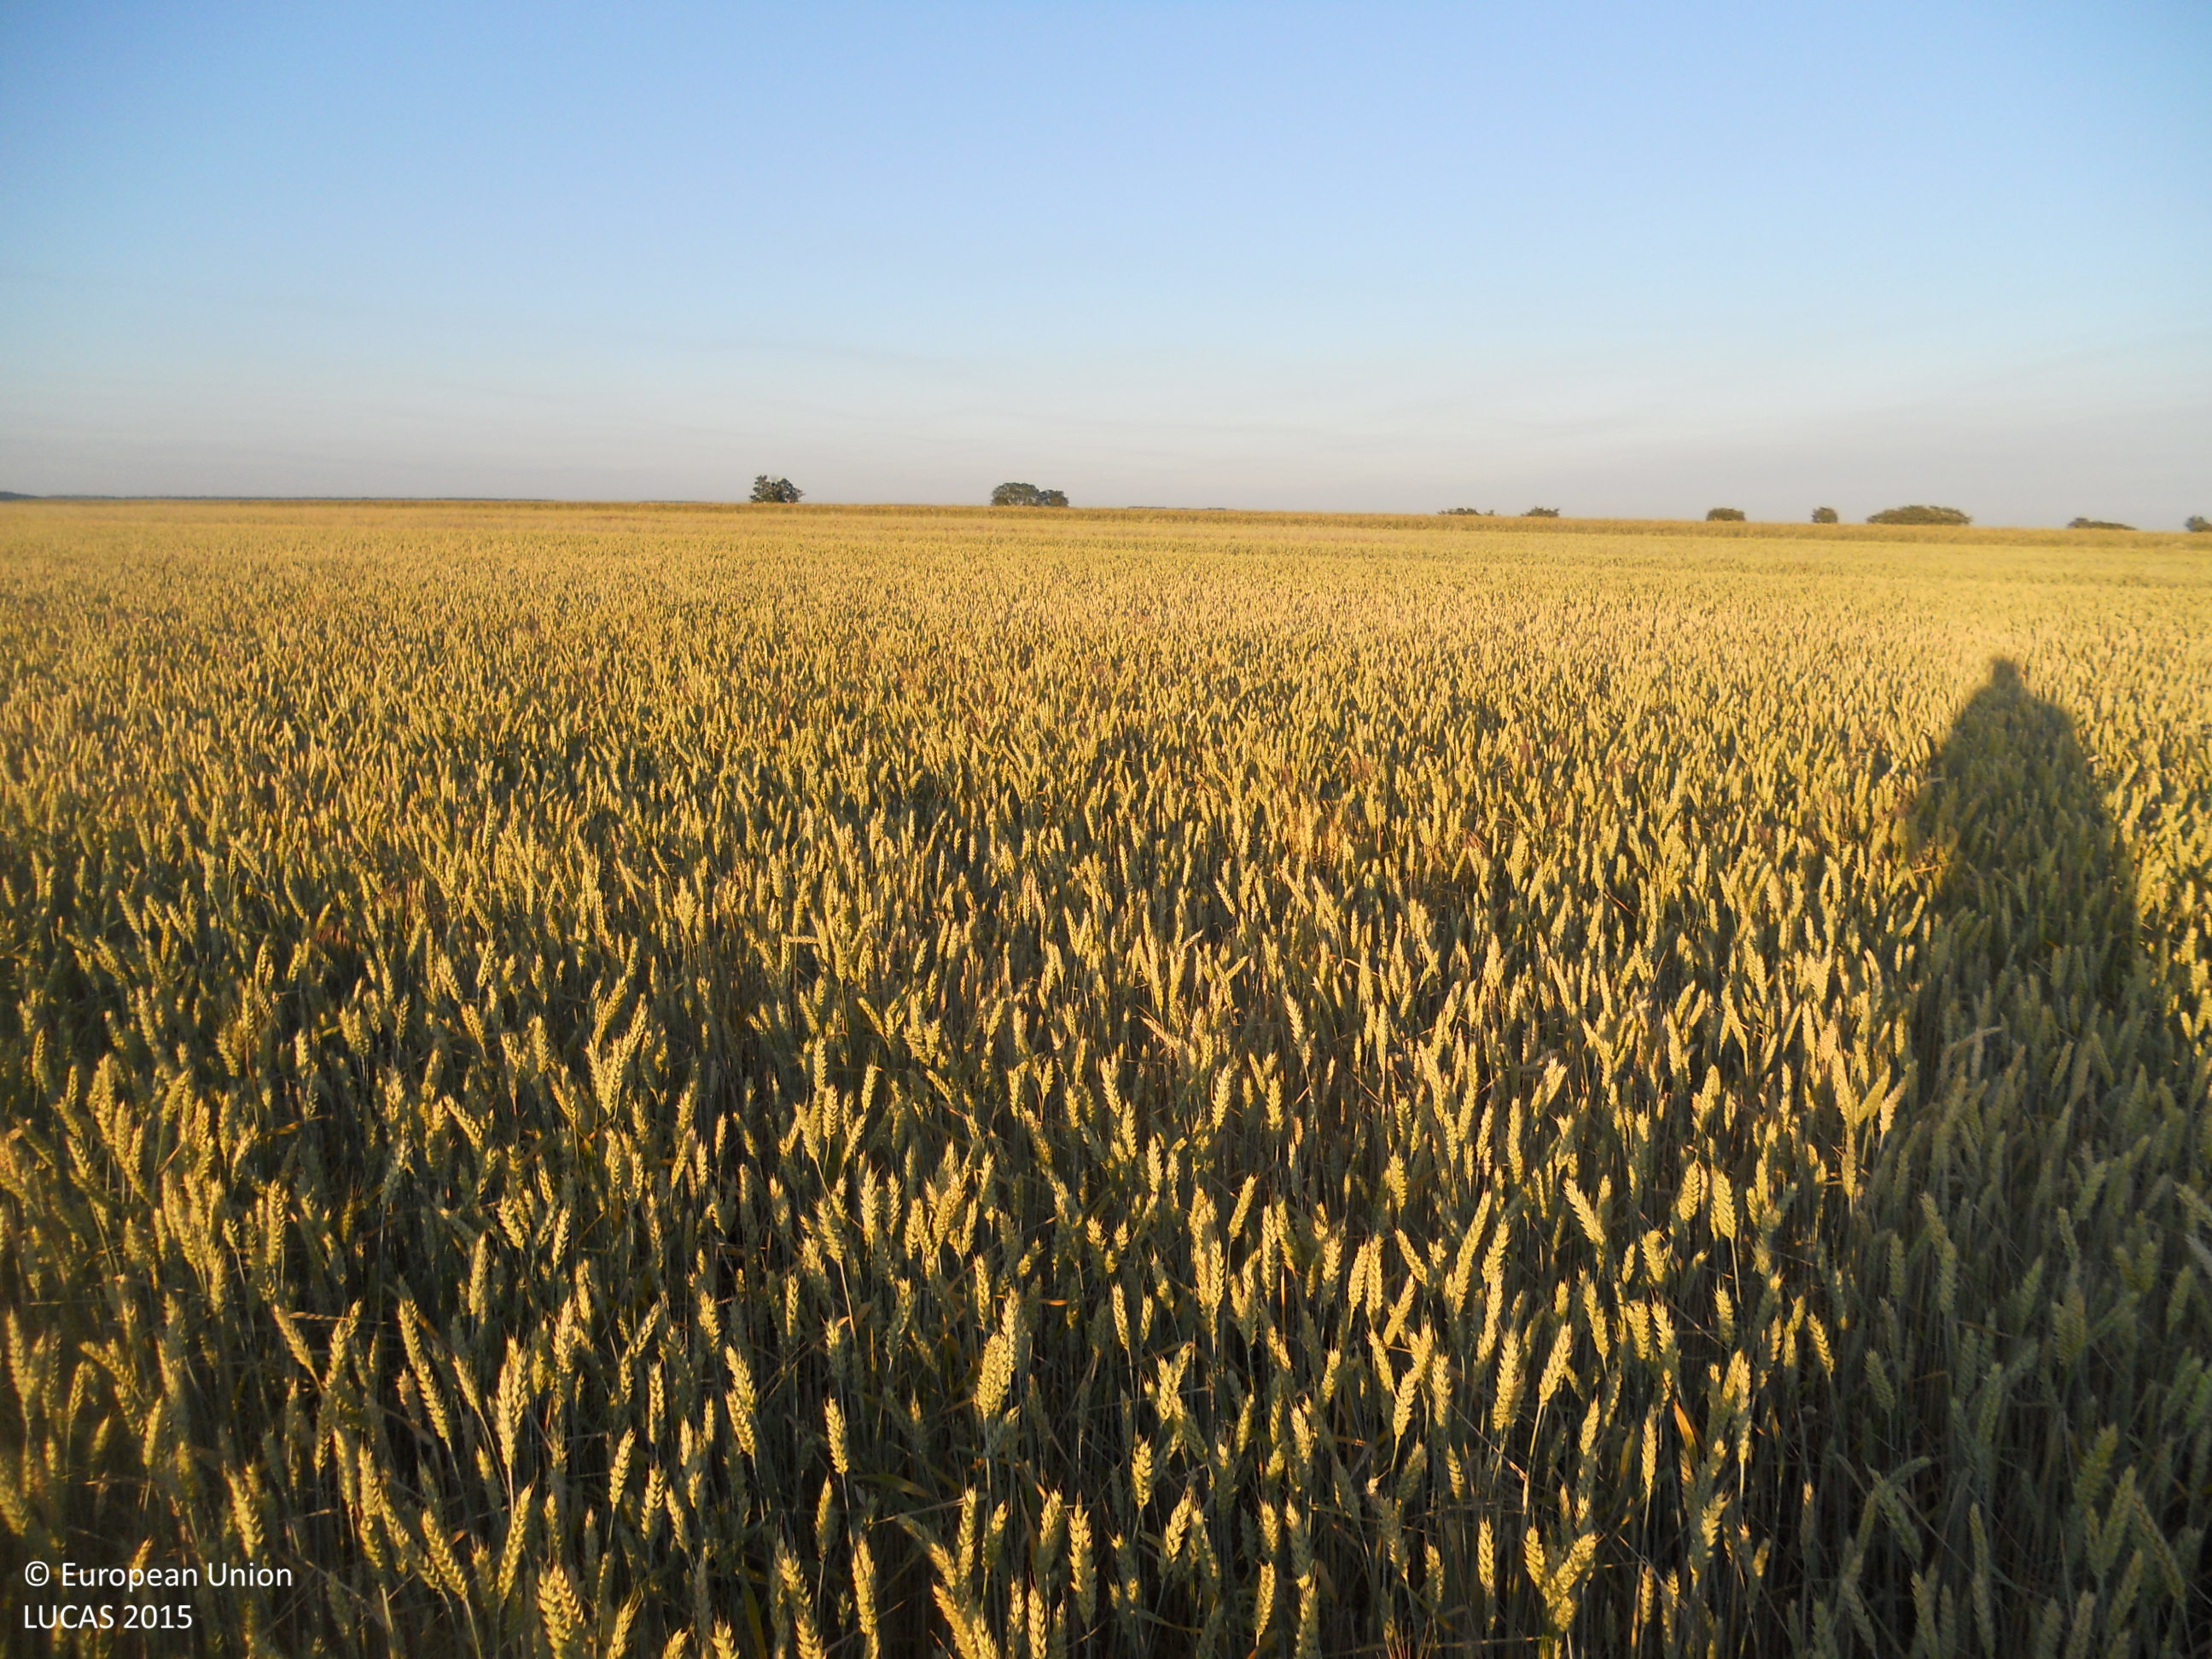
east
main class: Cropland
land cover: Common wheat
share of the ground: > 75 %
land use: Agriculture (excluding fallow land and kitchen gardens)
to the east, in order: Common wheat; Rye; Grass margins; Ditches and canals; Grass margins; Common wheat; Grass margins; Ditches and canals; Grass margins; Oats; Grass margins; Ditches and canals; Grass margins; Oats
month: June
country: ES
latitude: 42.4747
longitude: -4.8108
